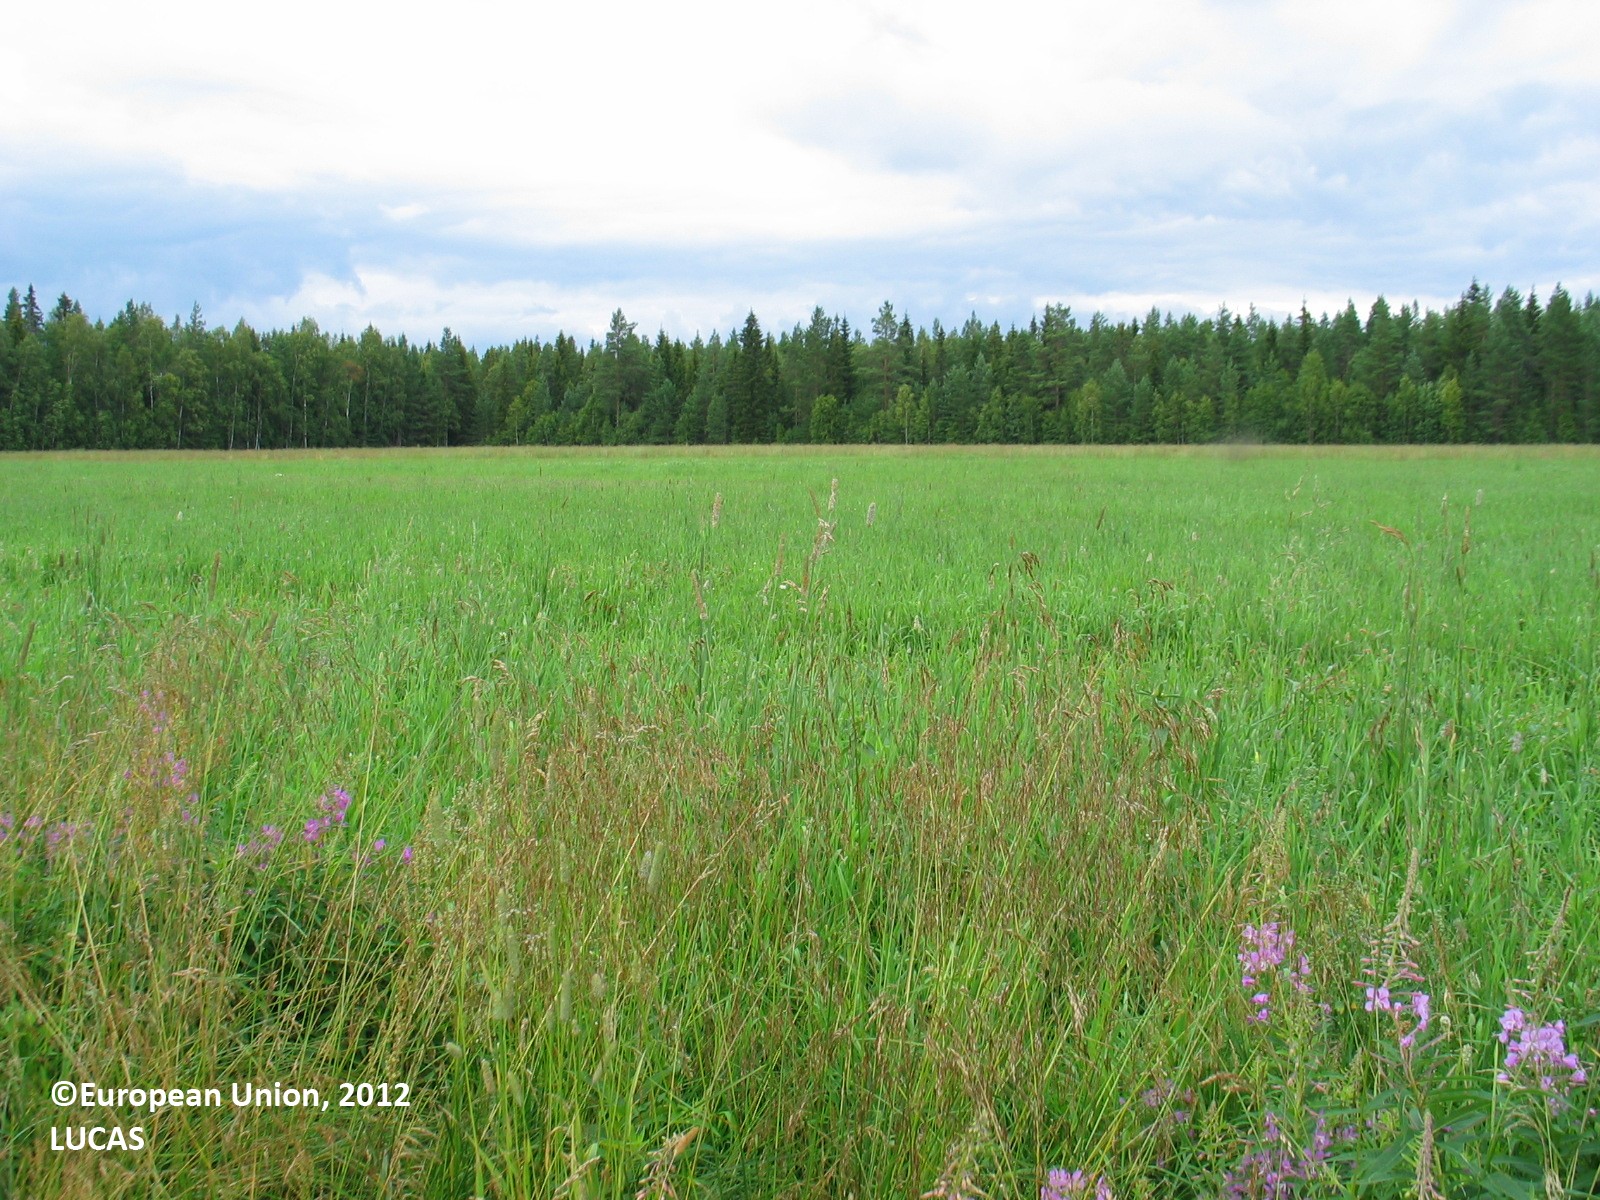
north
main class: Grassland
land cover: Grassland without tree/shrub cover
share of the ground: > 75 %
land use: Agriculture (excluding fallow land and kitchen gardens)
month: July
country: FI
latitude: 64.7676
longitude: 26.1435
